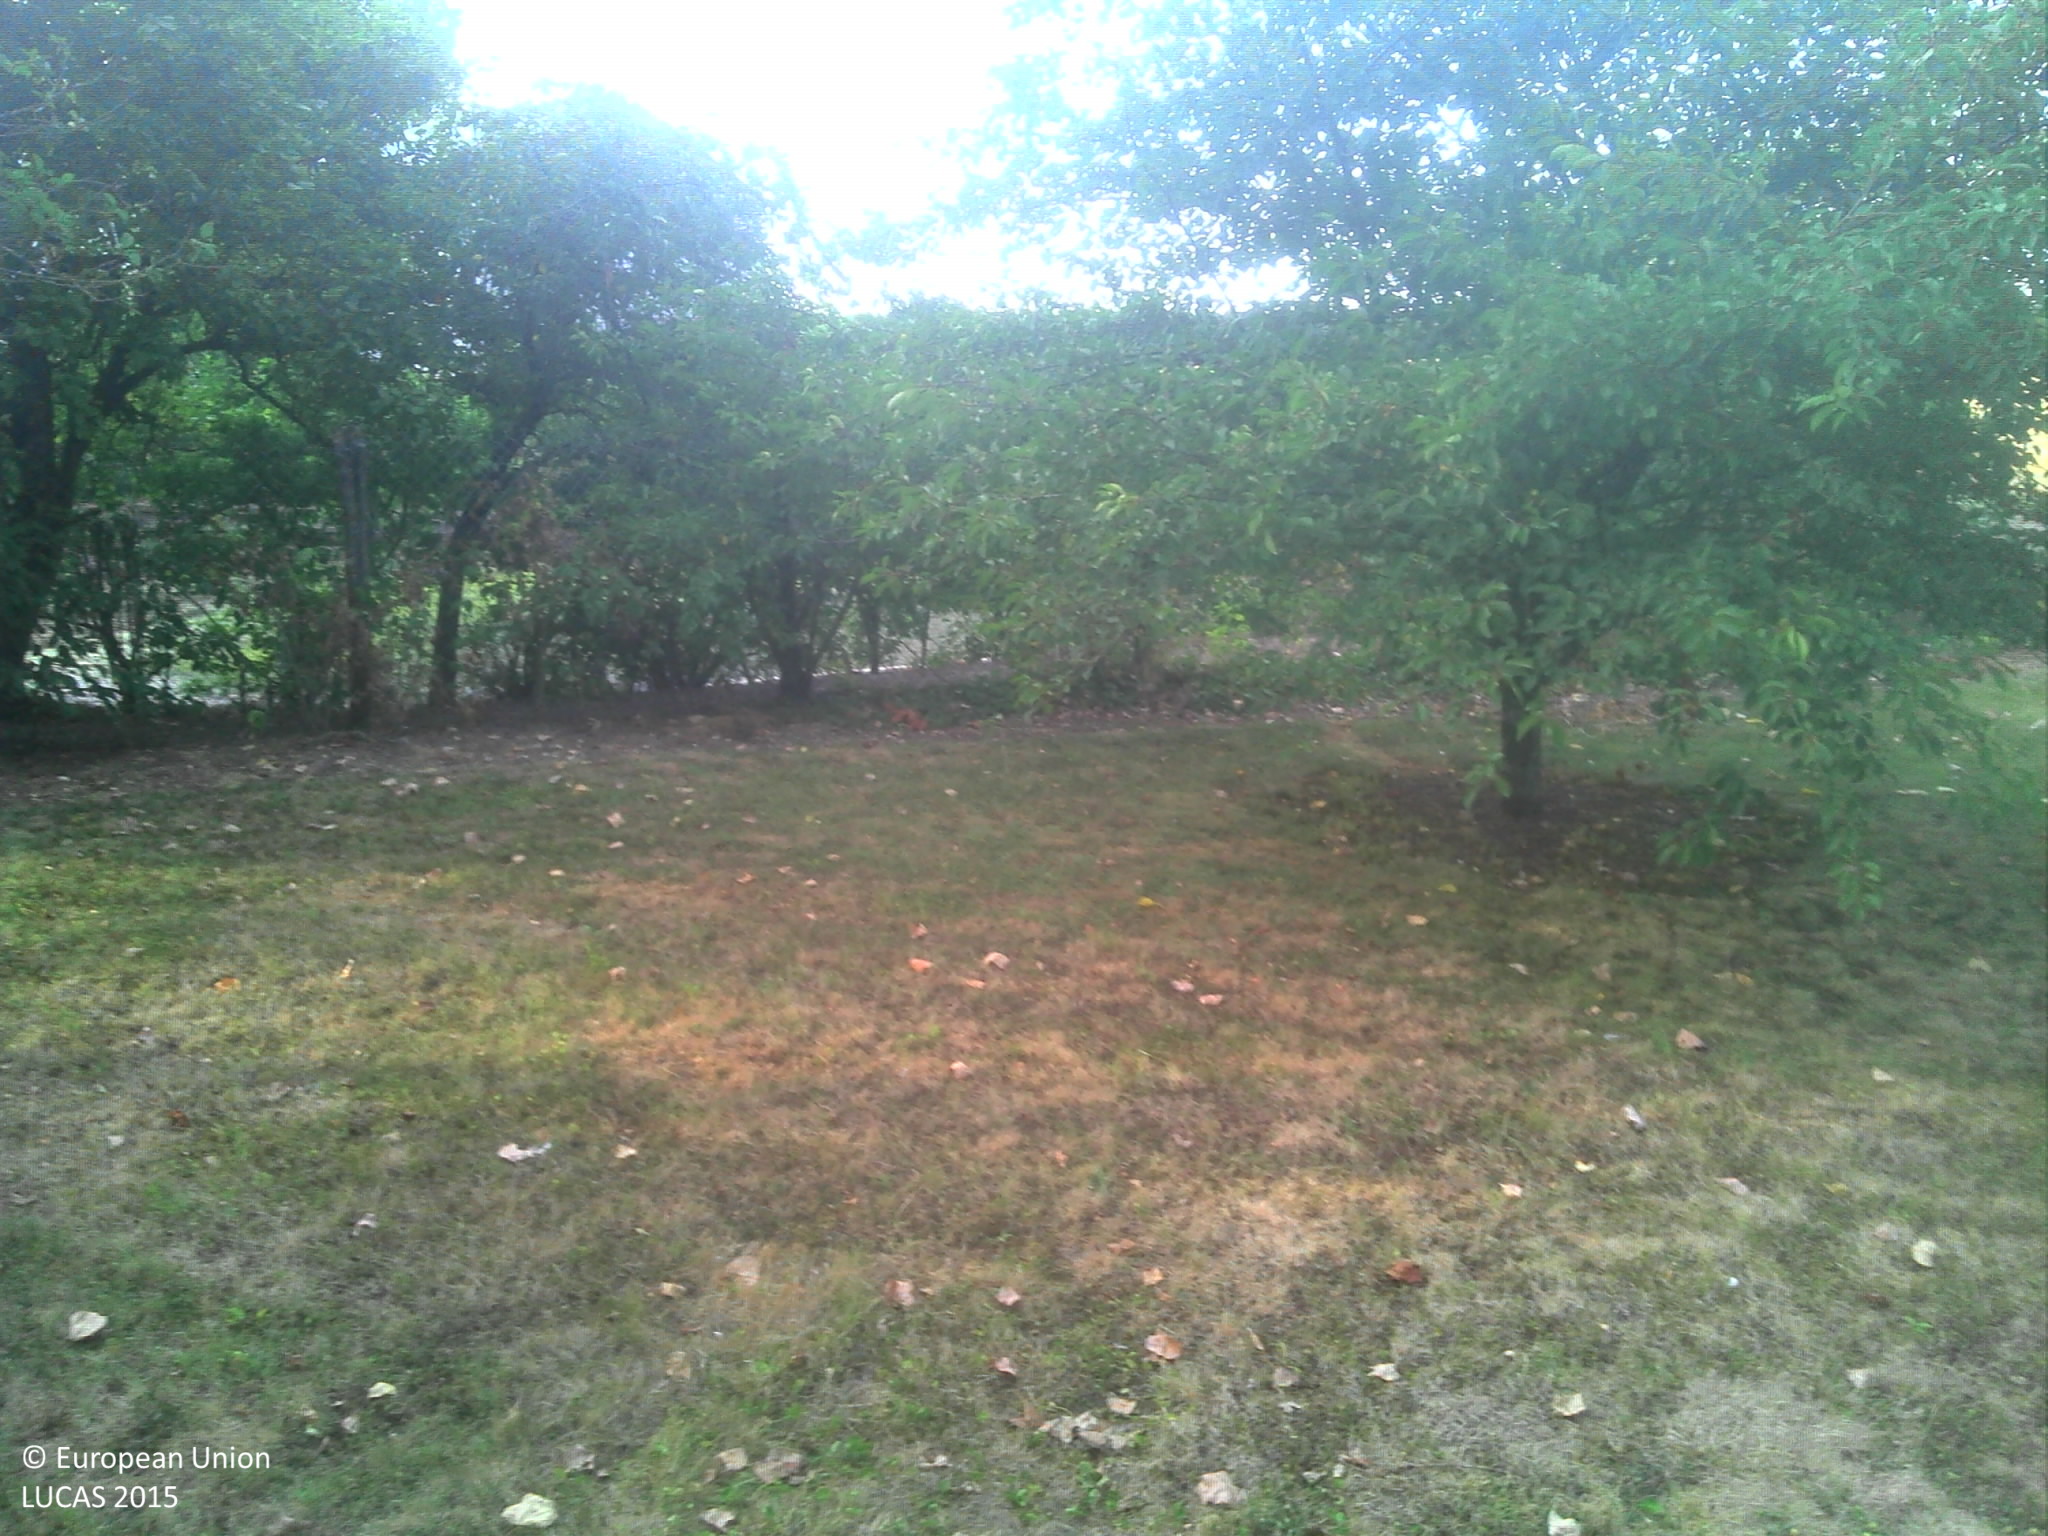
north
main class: Grassland
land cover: Grassland with sparse tree/shrub cover
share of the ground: > 75 %
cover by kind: herbaceous plants 95 %, broadleaved forest trees 5 %
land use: Residential
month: July
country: FR
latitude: 47.8206
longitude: 1.4768
